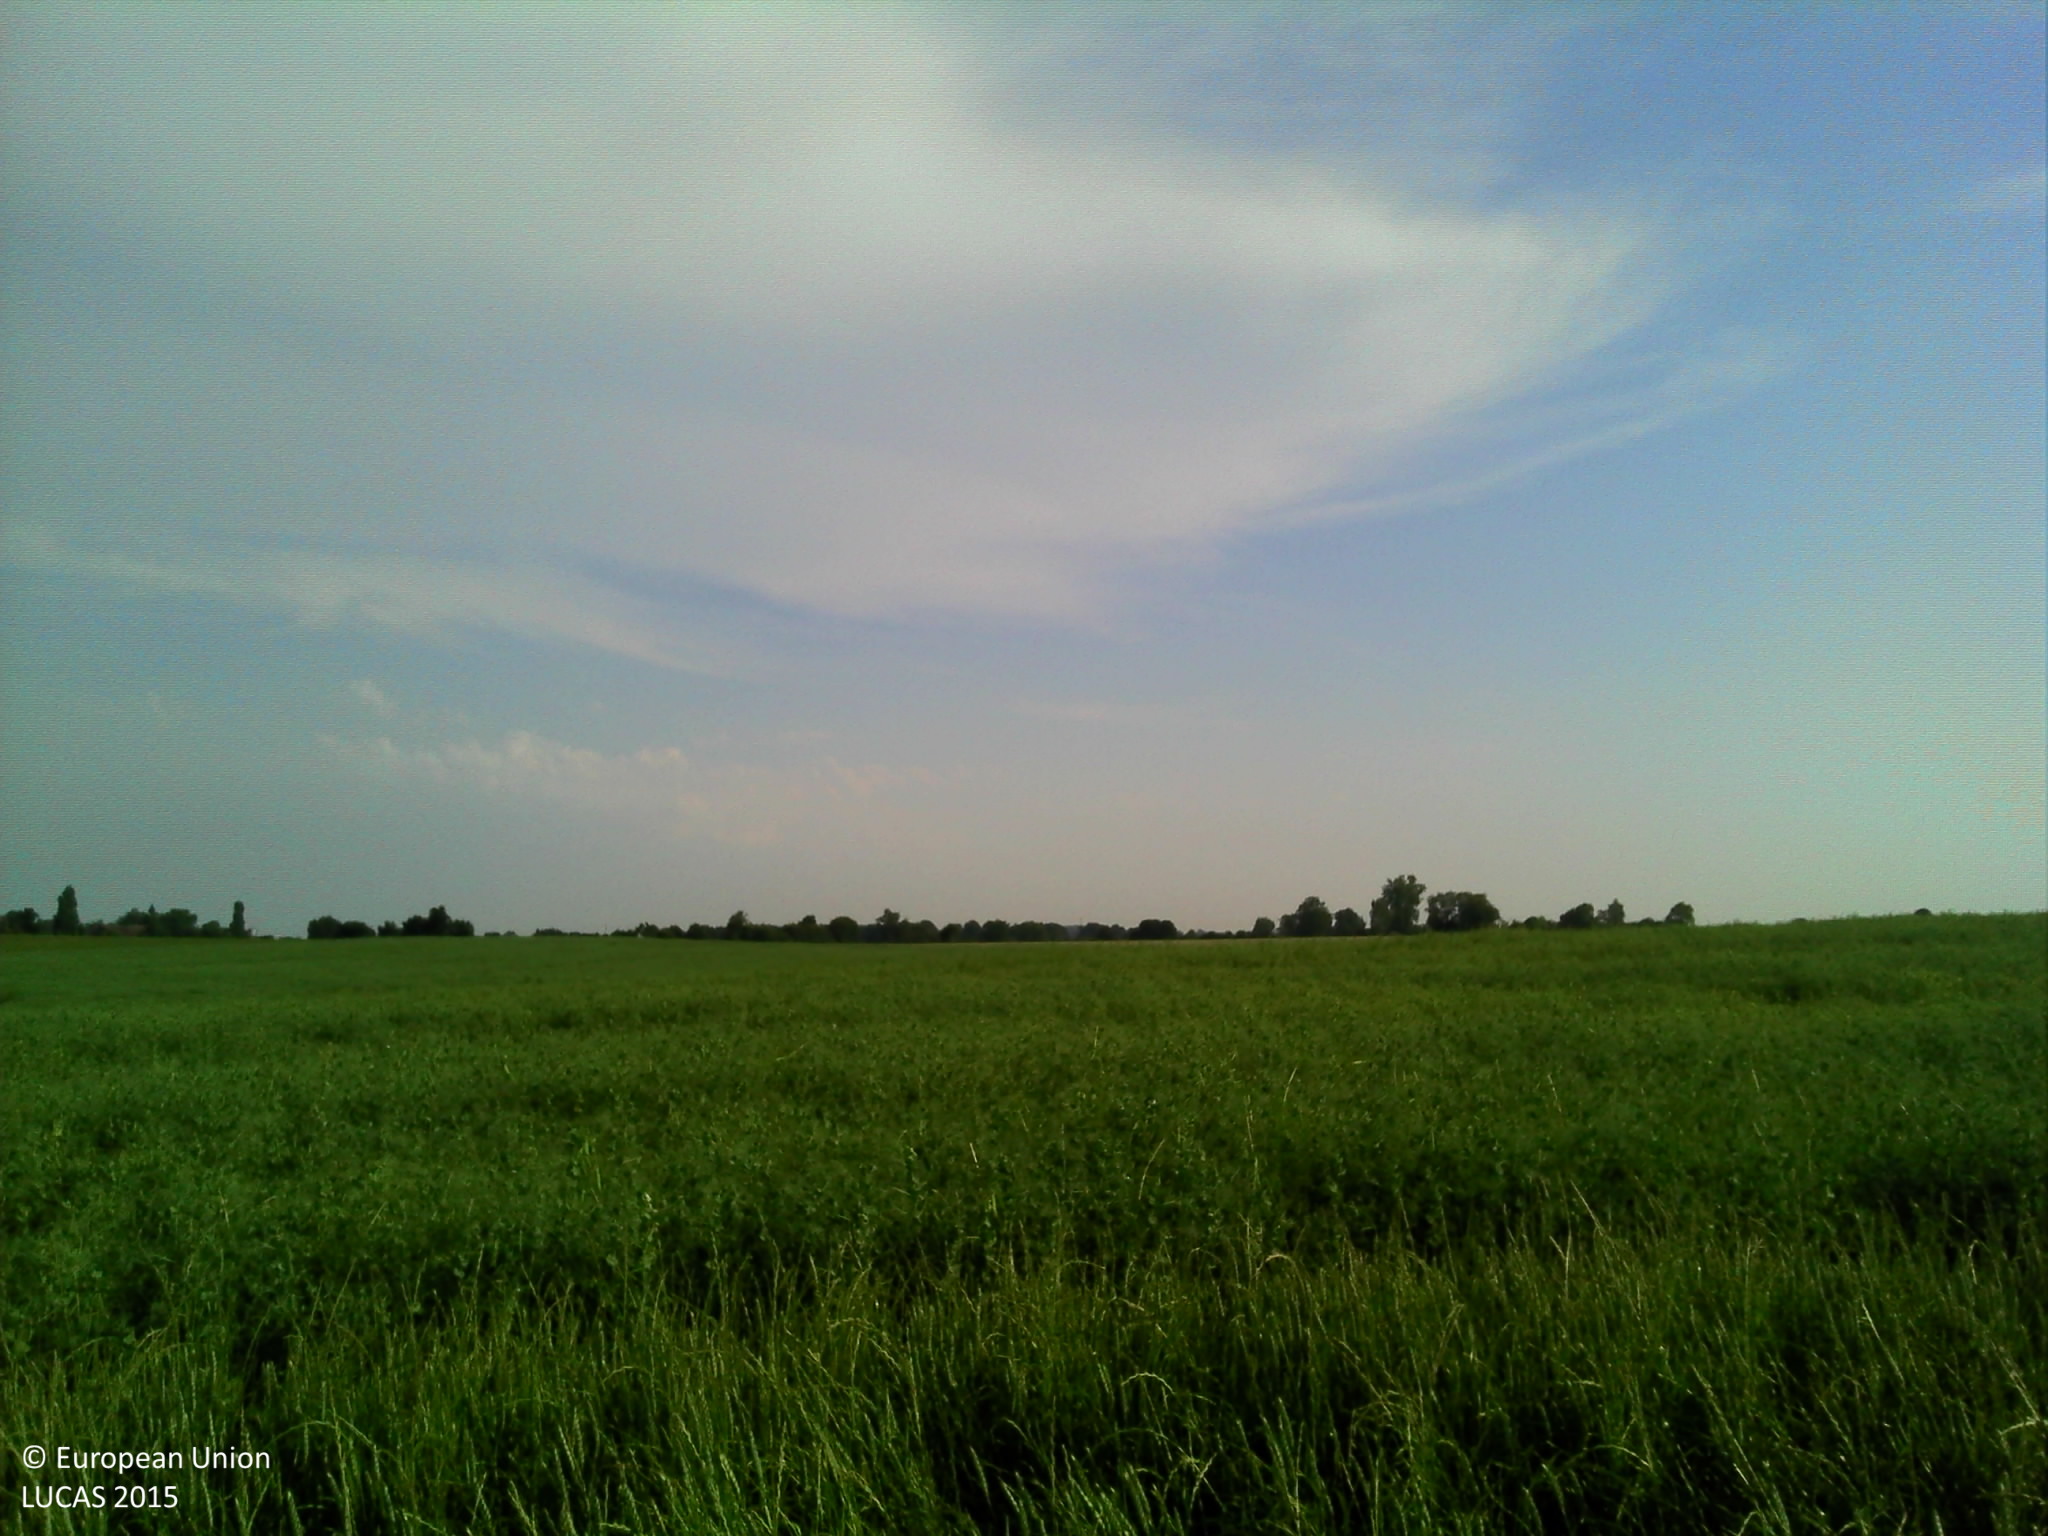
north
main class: Cropland
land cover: Mixed cereals for fodder
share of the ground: > 75 %
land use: Agriculture (excluding fallow land and kitchen gardens)
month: June
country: FR
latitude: 47.9464
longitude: -0.0294
